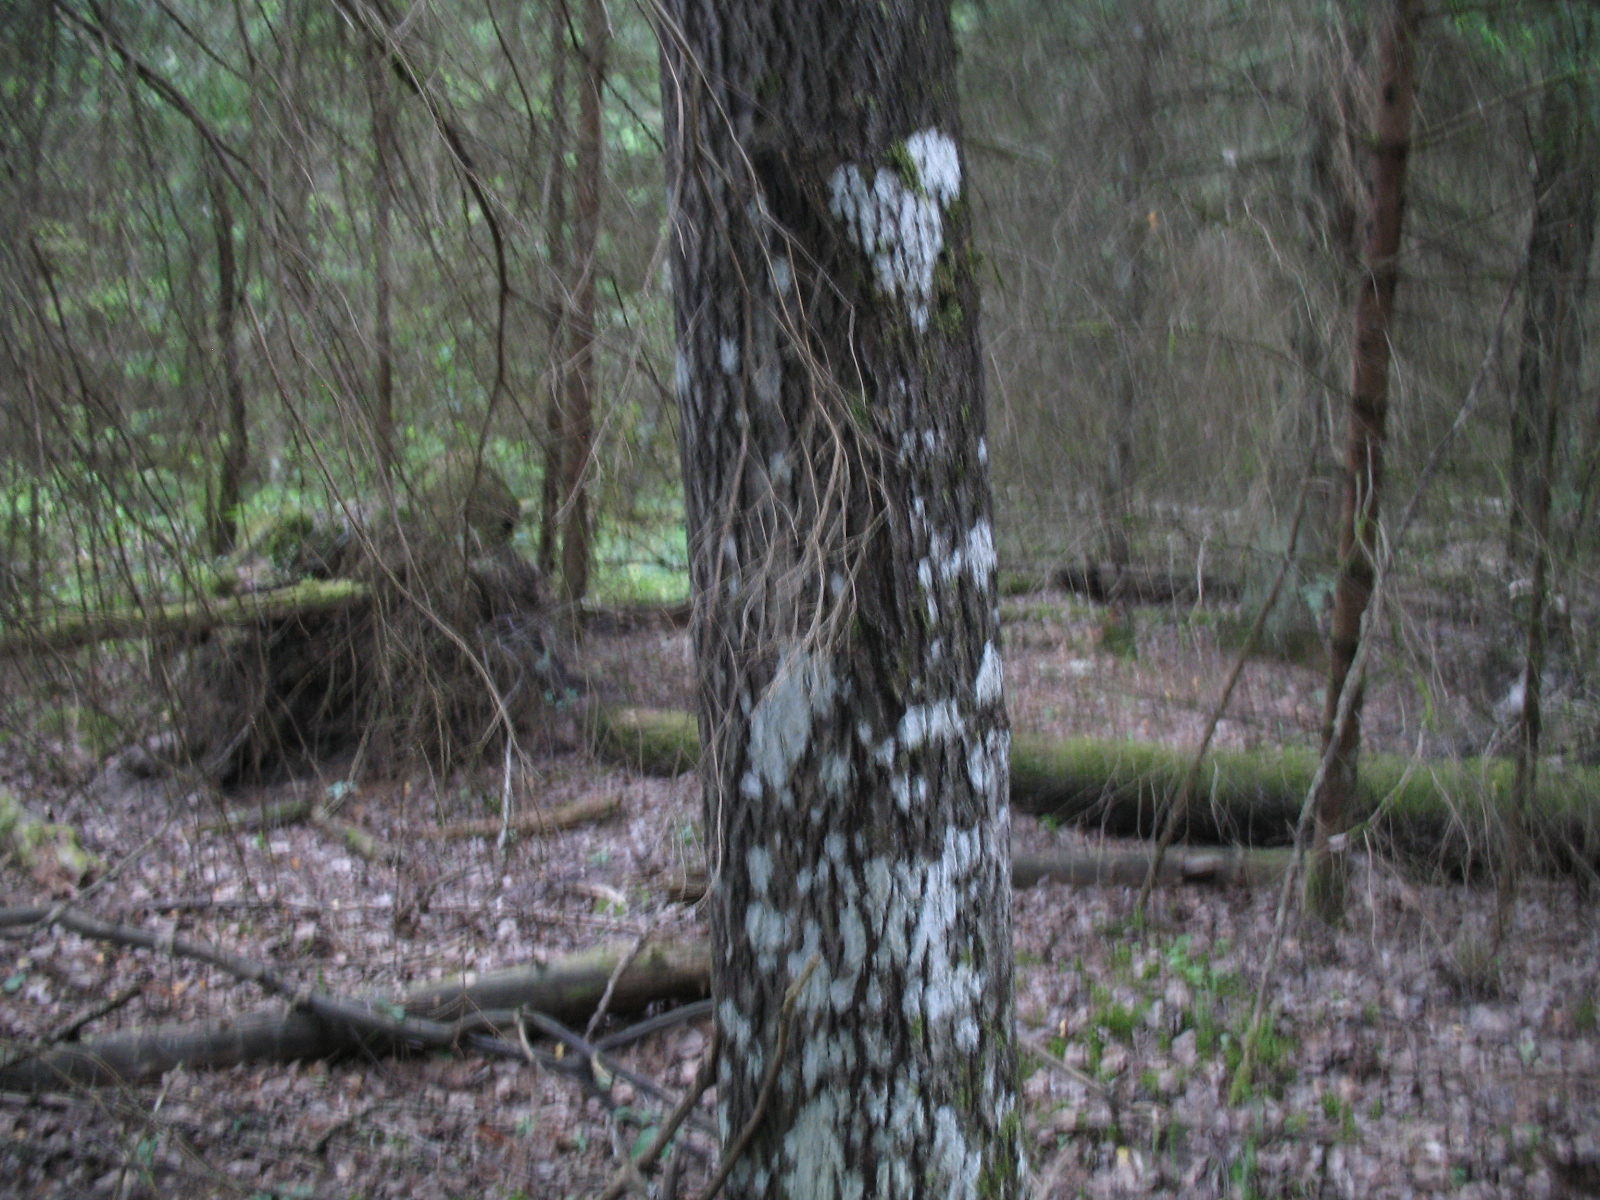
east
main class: Woodland
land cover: Spruce dominated mixed woodland
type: hemiboreal forest and nemoral coniferous forest and mixed broadleaved-coniferous forest
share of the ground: > 75 %
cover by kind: coniferous forest trees 50 %, broadleaved forest trees 45 %, herbaceous plants 5 %
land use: Forestry
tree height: > 5 m
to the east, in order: Spruce dominated mixed woodland; Other mixed woodland; Other coniferous woodland; Other mixed woodland
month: June
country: LV
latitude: 56.7637
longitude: 23.8720
